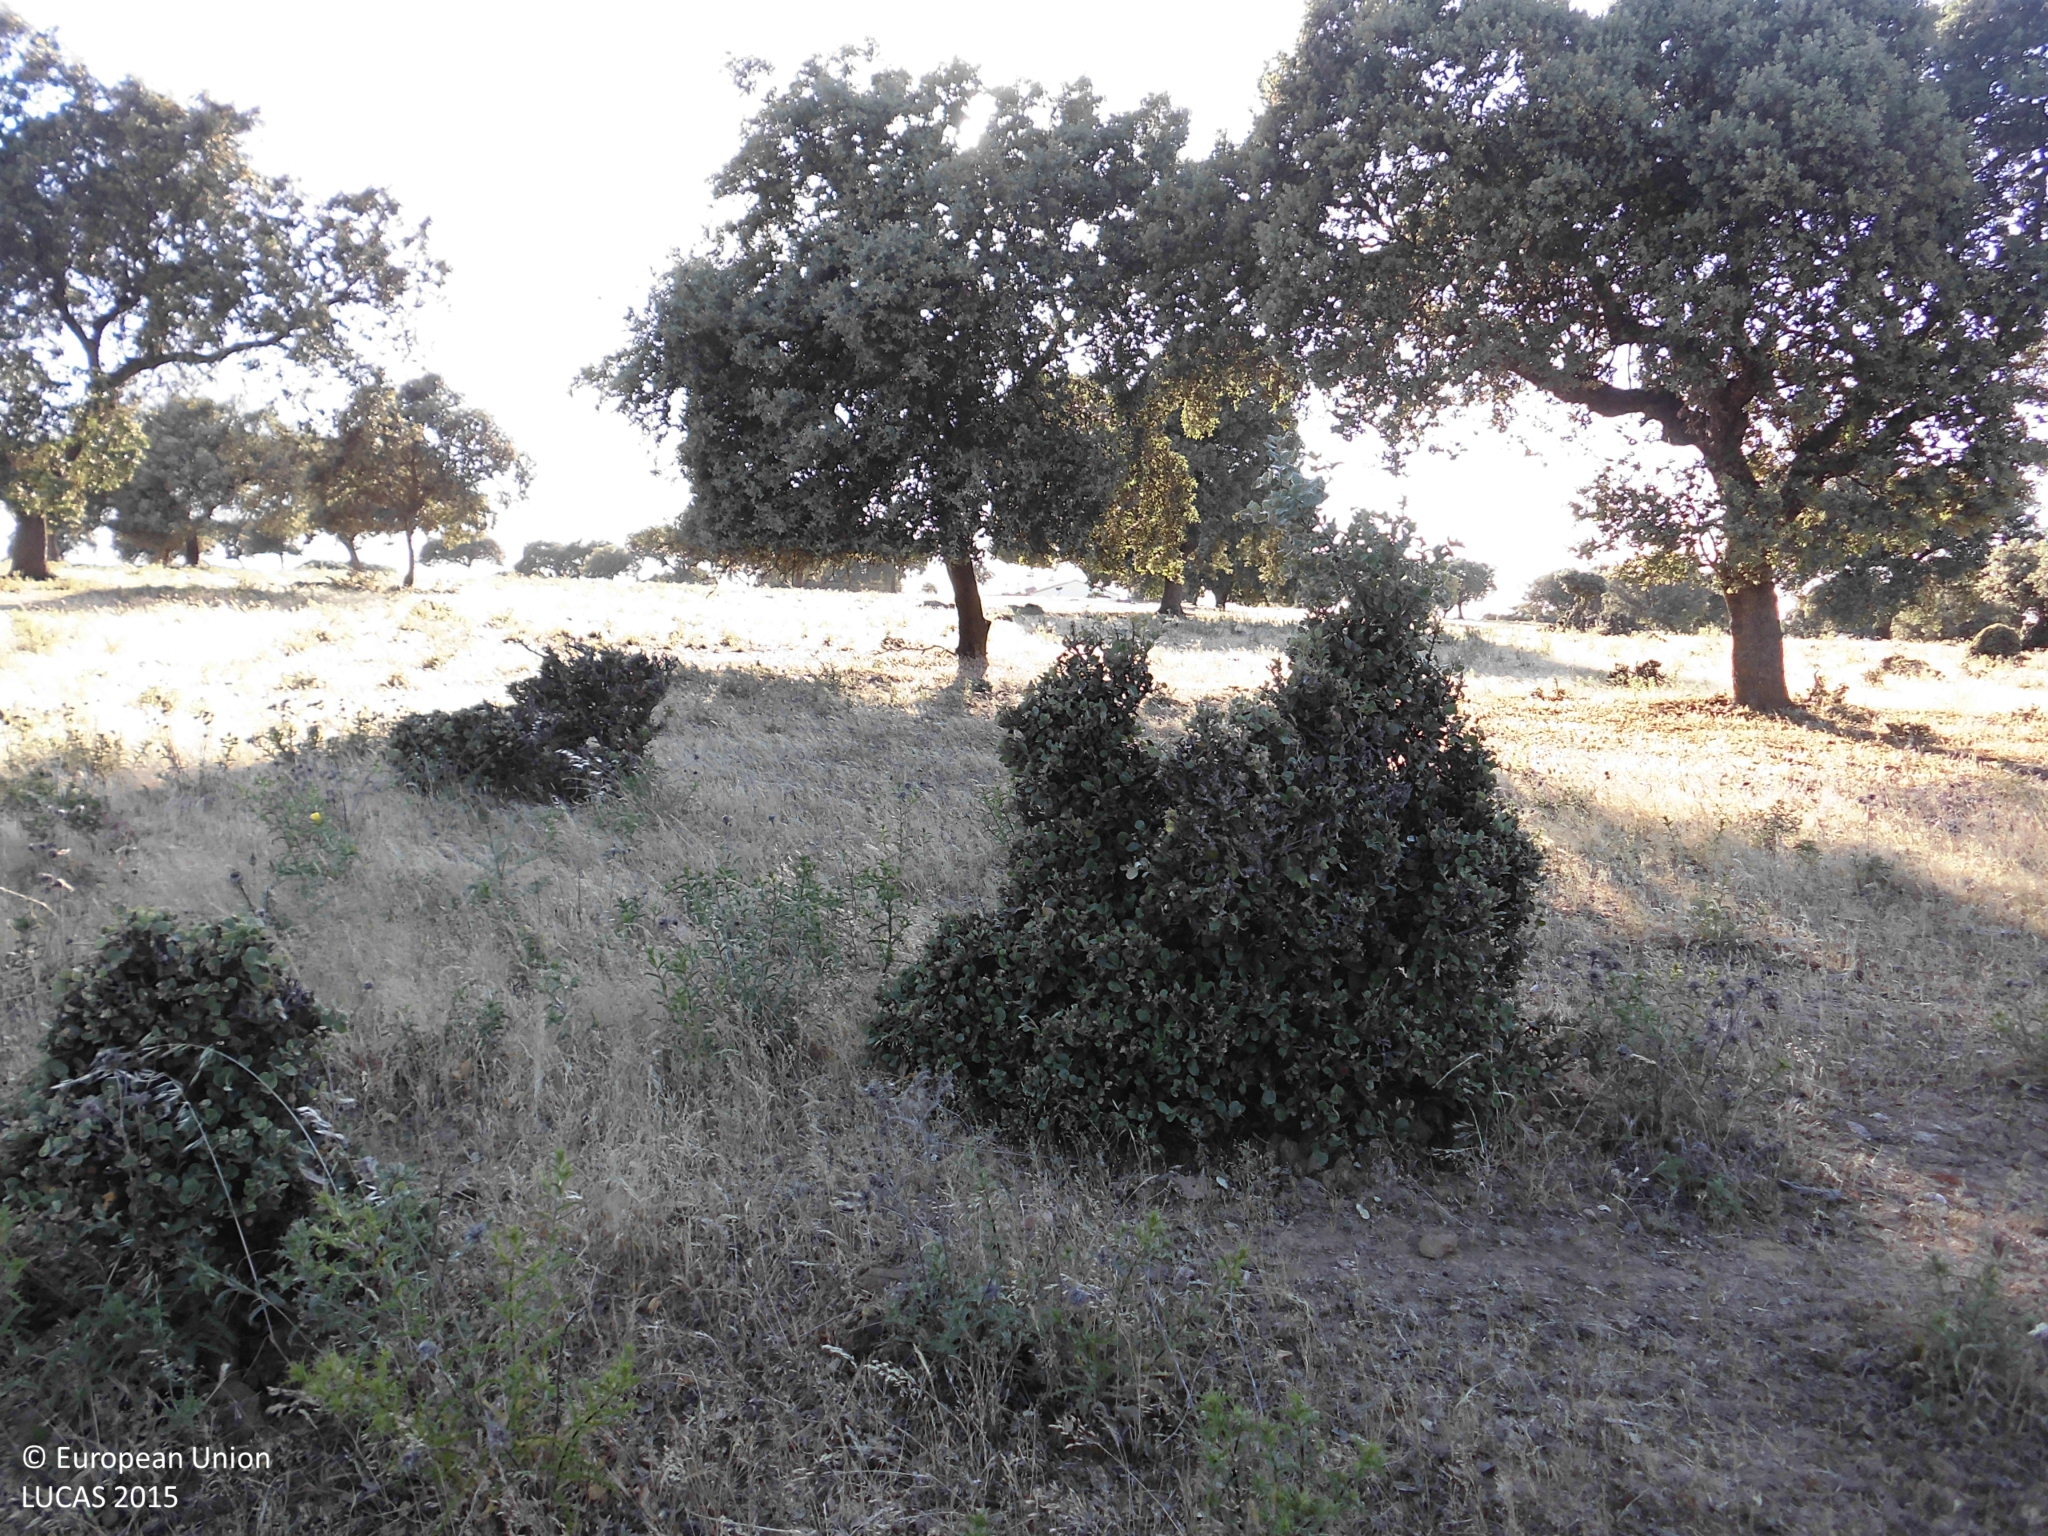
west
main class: Grassland
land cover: Grassland with sparse tree/shrub cover
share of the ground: > 75 %
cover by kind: herbaceous plants 85 %, broadleaved forest trees 5 %, shrubs 5 %, unconsolidated bare surface 5 %
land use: Agriculture (excluding fallow land and kitchen gardens)
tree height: < 5 m
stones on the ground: < 10 %
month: May
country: ES
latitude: 39.4255
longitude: -5.9859
